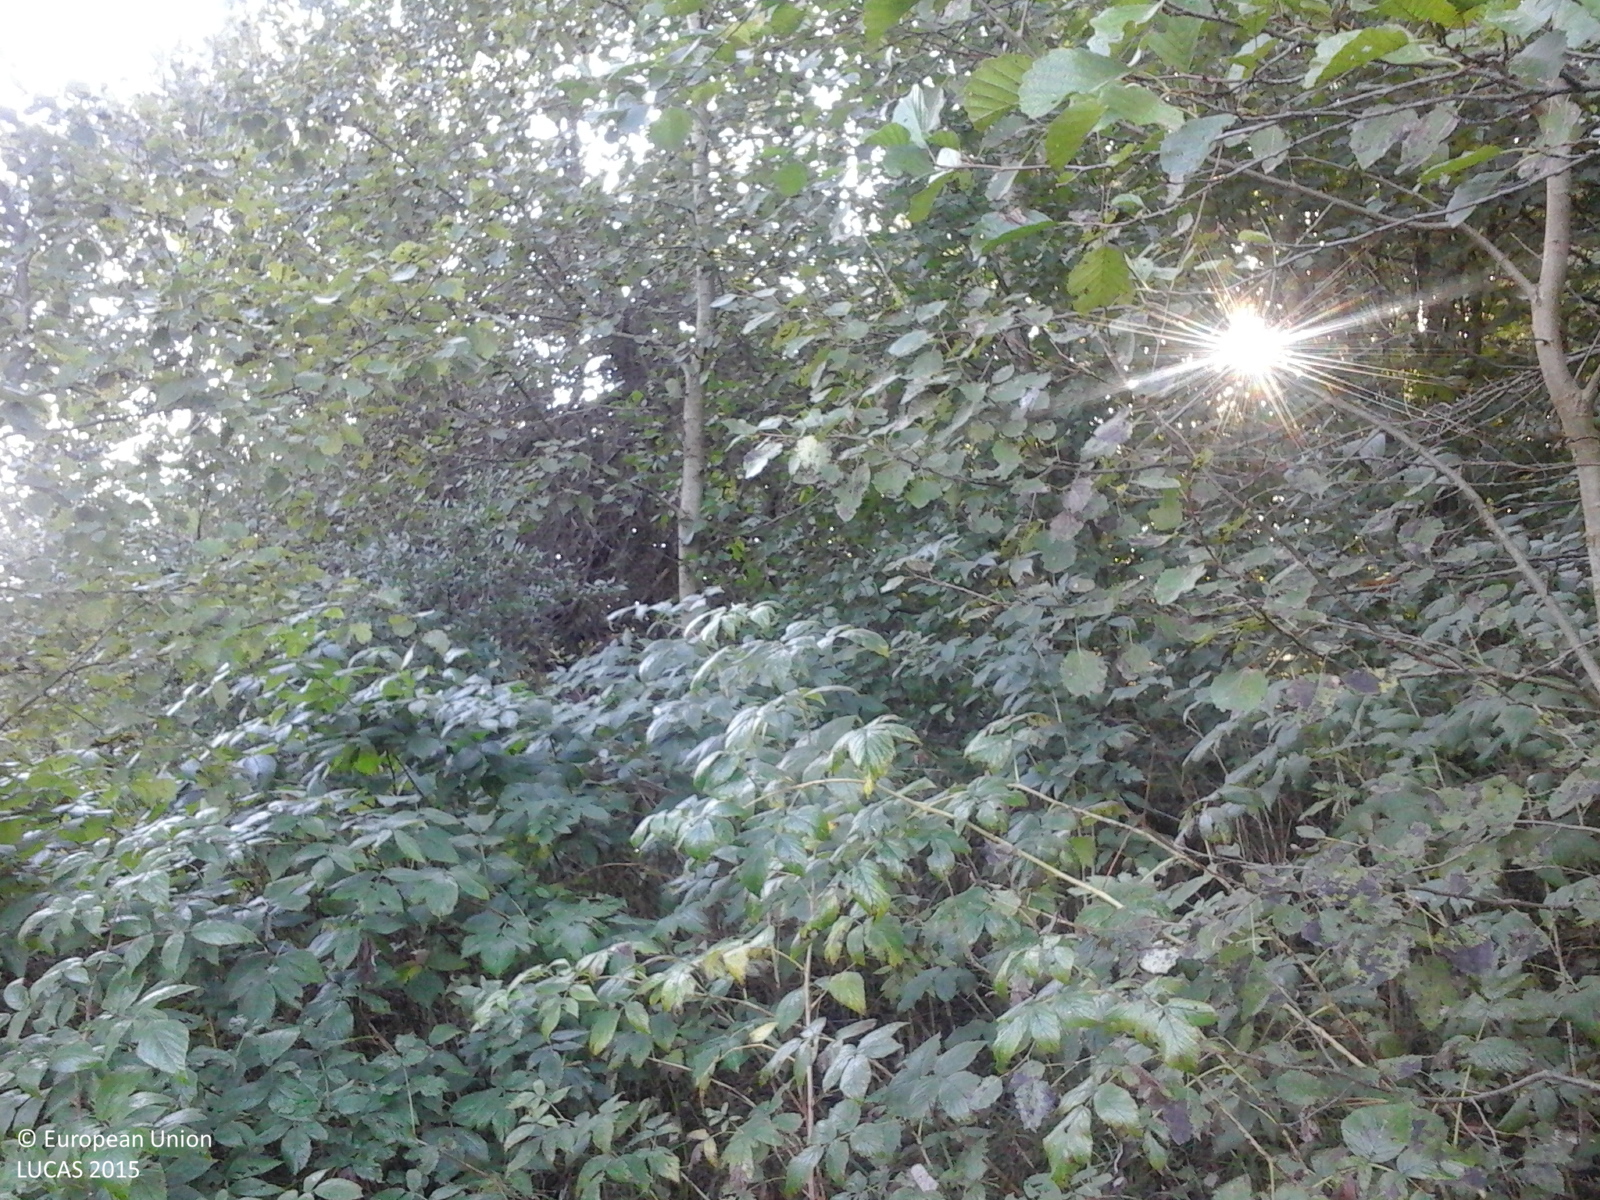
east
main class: Woodland
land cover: Broadleaved woodland
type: non-riverine alder, birch or aspen forest
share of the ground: > 75 %
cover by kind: broadleaved forest trees 100 %
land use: Forestry
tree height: > 5 m
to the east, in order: Broadleaved woodland; Grassland without tree/shrub cover; Electric lines; Broadleaved woodland; Ditches and canals; Broadleaved woodland; Grassland without tree/shrub cover; Paved roads, cycling and walking lanes
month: September
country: RO
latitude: 45.1094
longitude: 22.3053
